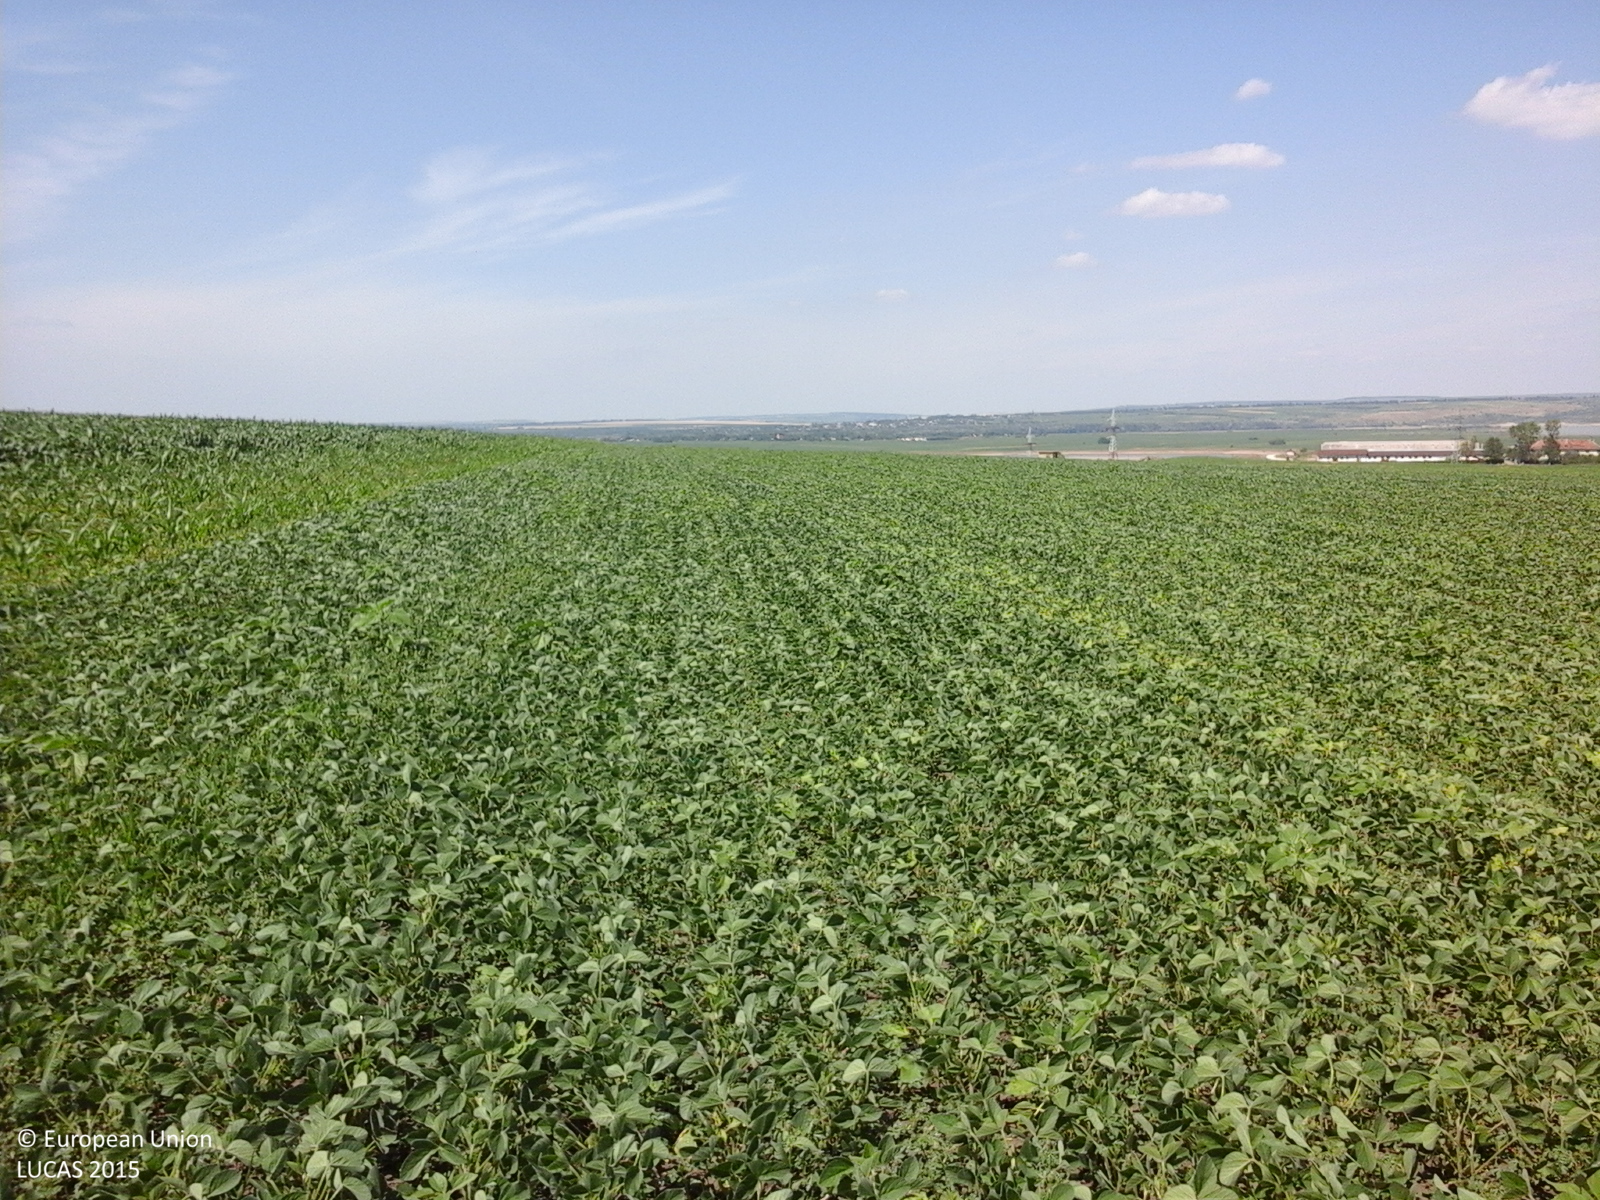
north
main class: Cropland
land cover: Soya
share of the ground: > 75 %
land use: Agriculture (excluding fallow land and kitchen gardens)
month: June
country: RO
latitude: 47.9545
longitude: 27.1298
